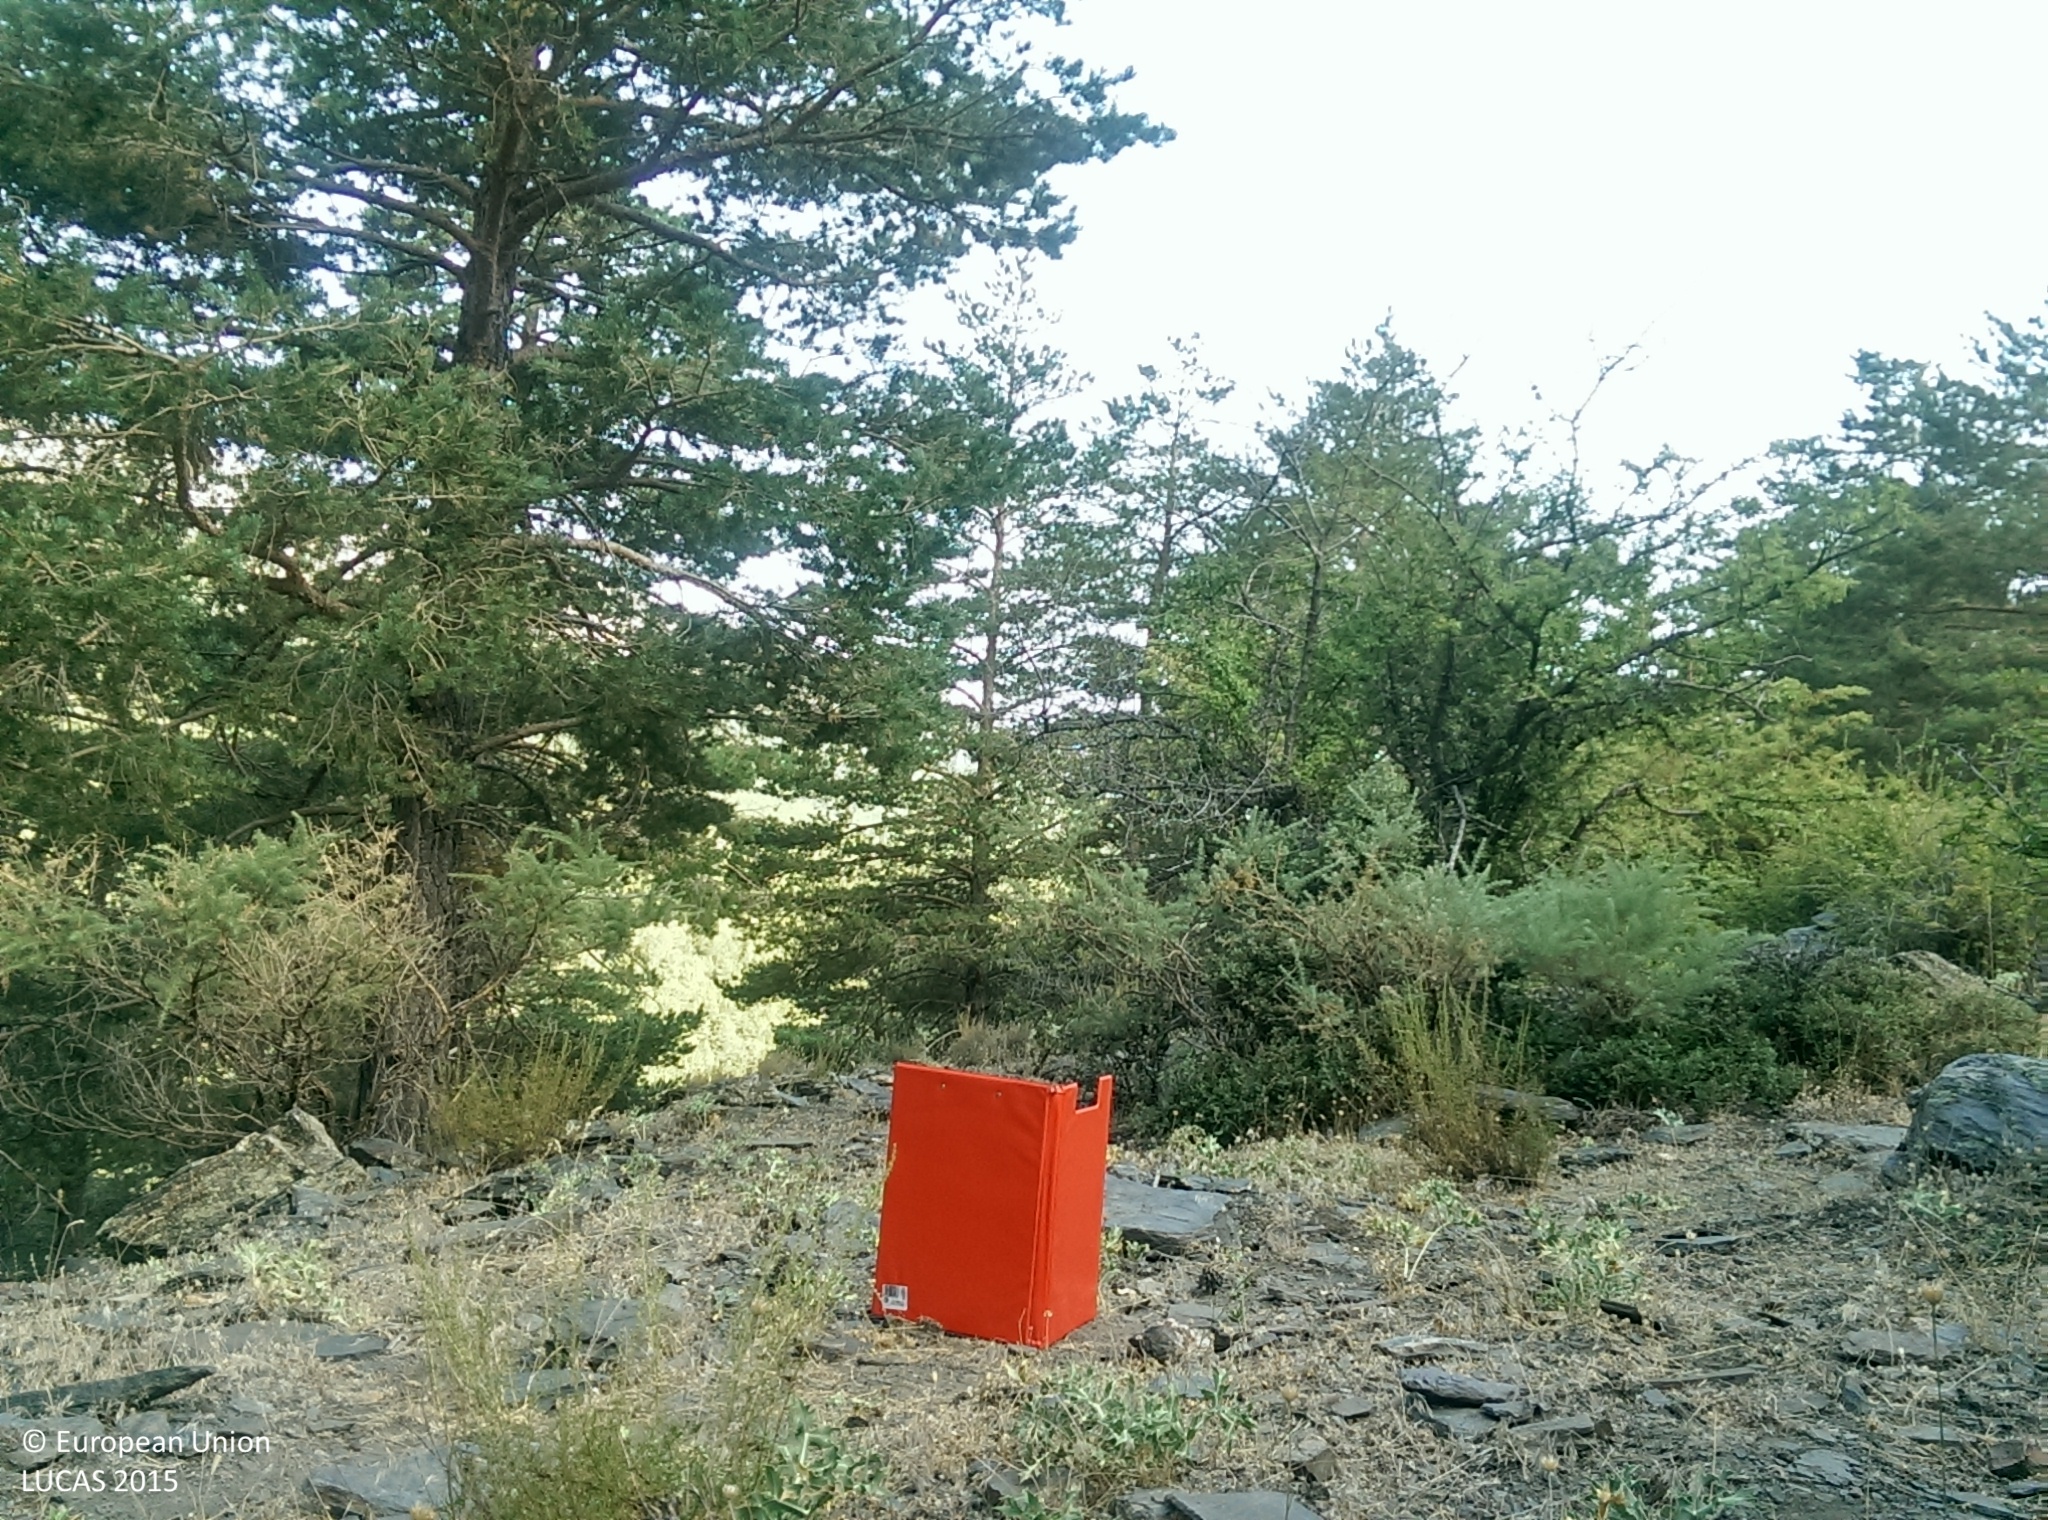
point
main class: Woodland
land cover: Pine dominated coniferous woodland
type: coniferous forest of the mediterranean region
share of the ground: 50 - 75 %
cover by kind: coniferous forest trees 50 %, herbaceous plants 15 %, broadleaved forest trees 10 %, shrubs 10 %, unconsolidated bare surface 10 %, consolidated bare surface 5 %
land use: Forestry
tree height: > 5 m
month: July
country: ES
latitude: 37.1186
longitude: -3.1862
